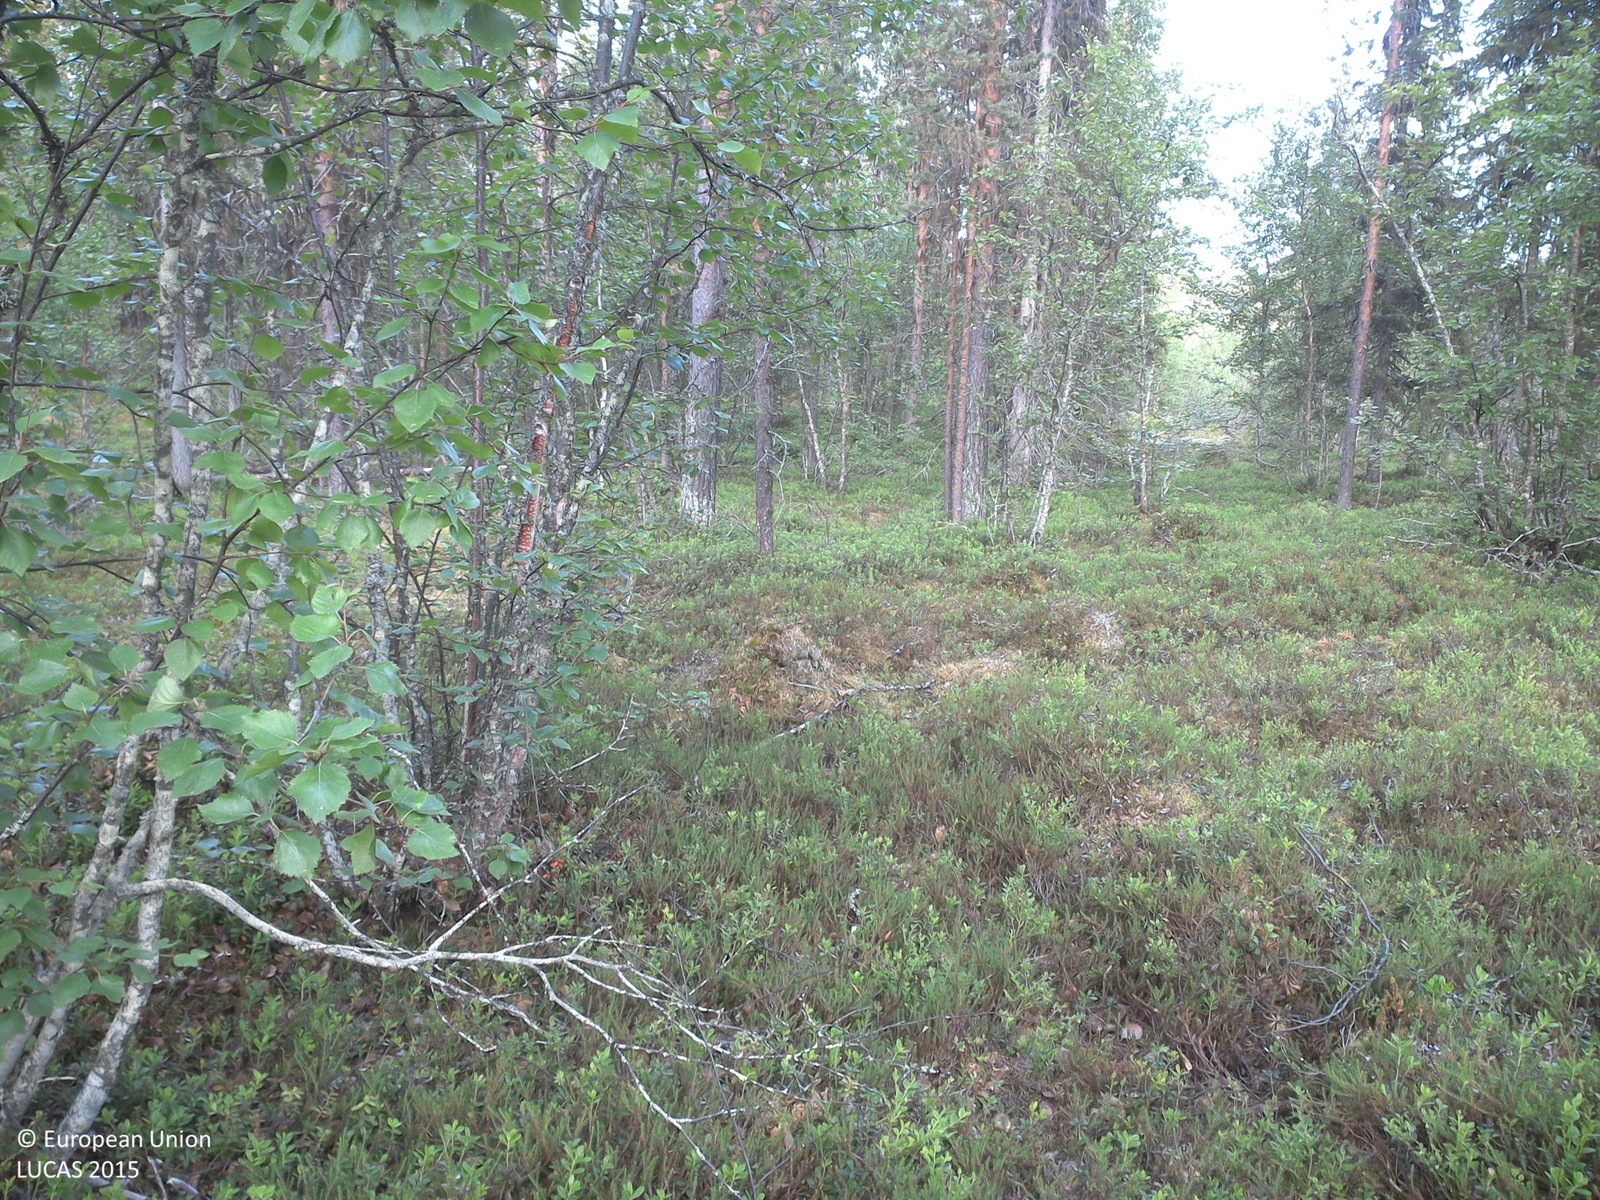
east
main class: Woodland
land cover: Pine dominated mixed woodland
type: boreal forest
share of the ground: 25 - 50 %
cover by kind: shrubs 60 %, coniferous forest trees 25 %, broadleaved forest trees 10 %, lichens and mosses 5 %
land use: Forestry
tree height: > 5 m
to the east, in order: Pine dominated mixed woodland; Spruce dominated mixed woodland; Ditches and canals; Peatbogs
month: July
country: SE
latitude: 67.5072
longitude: 22.6784
